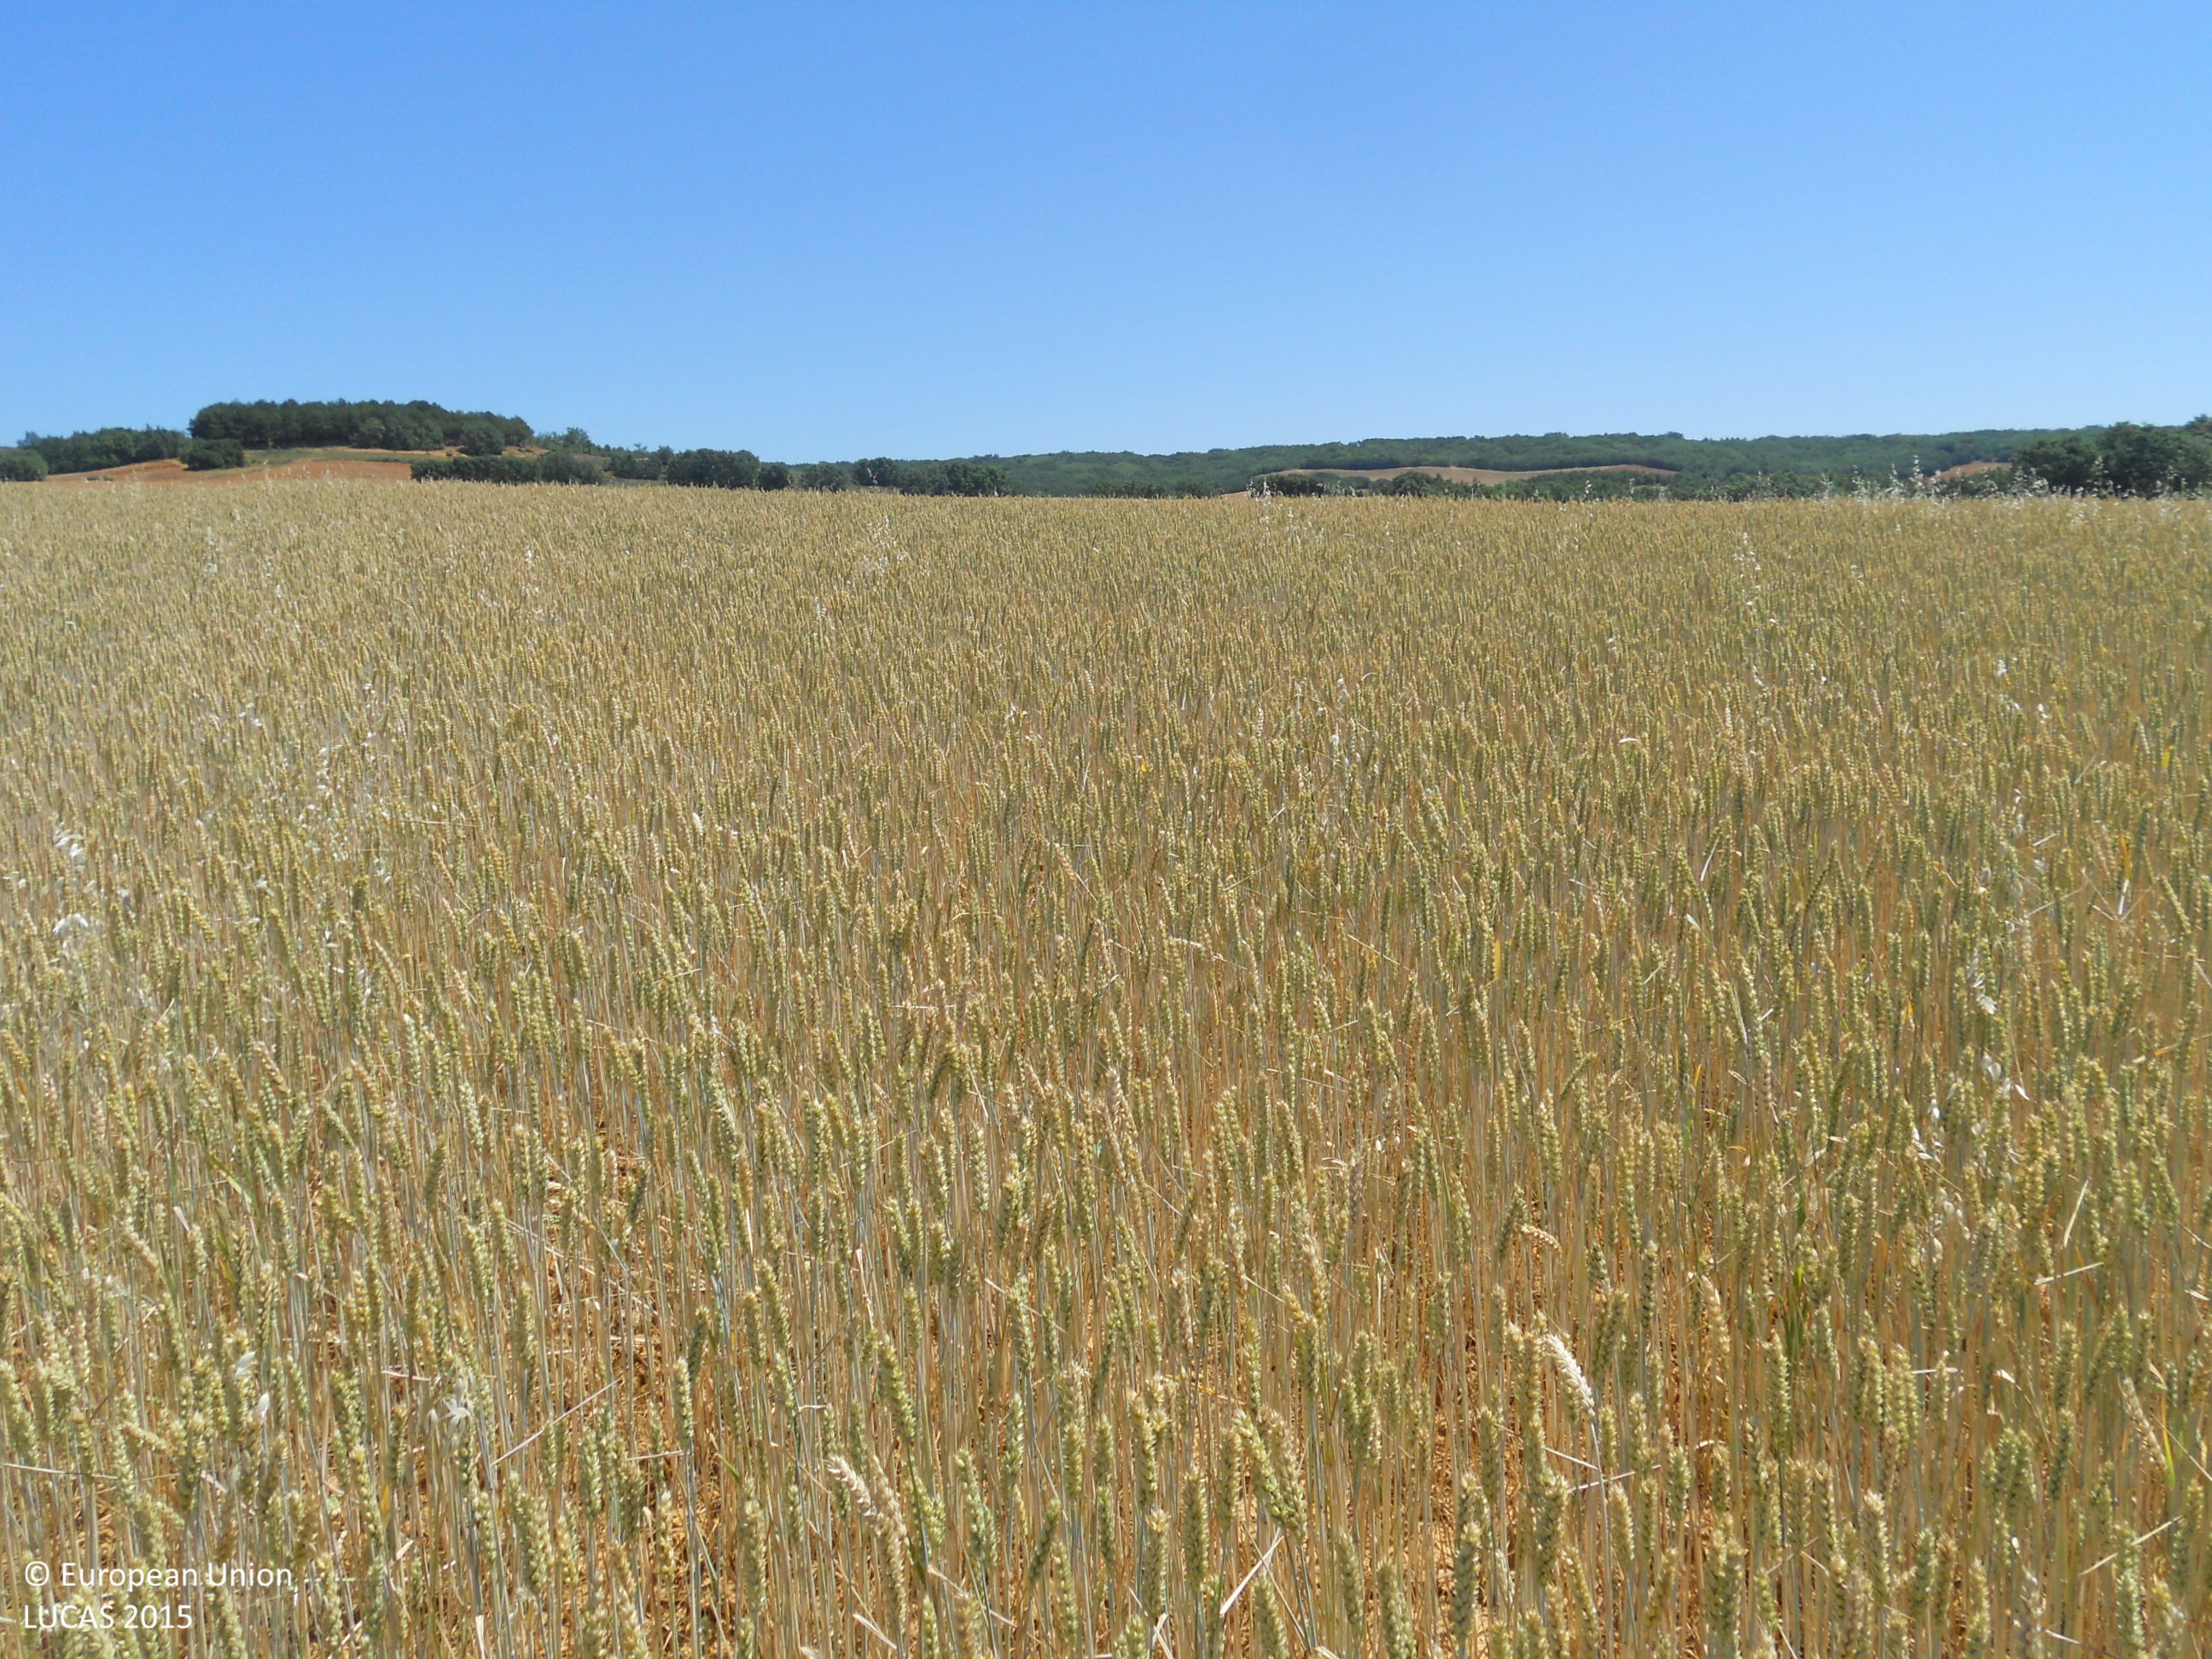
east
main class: Cropland
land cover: Common wheat
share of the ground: > 75 %
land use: Agriculture (excluding fallow land and kitchen gardens)
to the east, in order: Common wheat; Grass margins; Tracks; Grass margins; Other bare soil
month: June
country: ES
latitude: 42.5734
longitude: -5.0095
